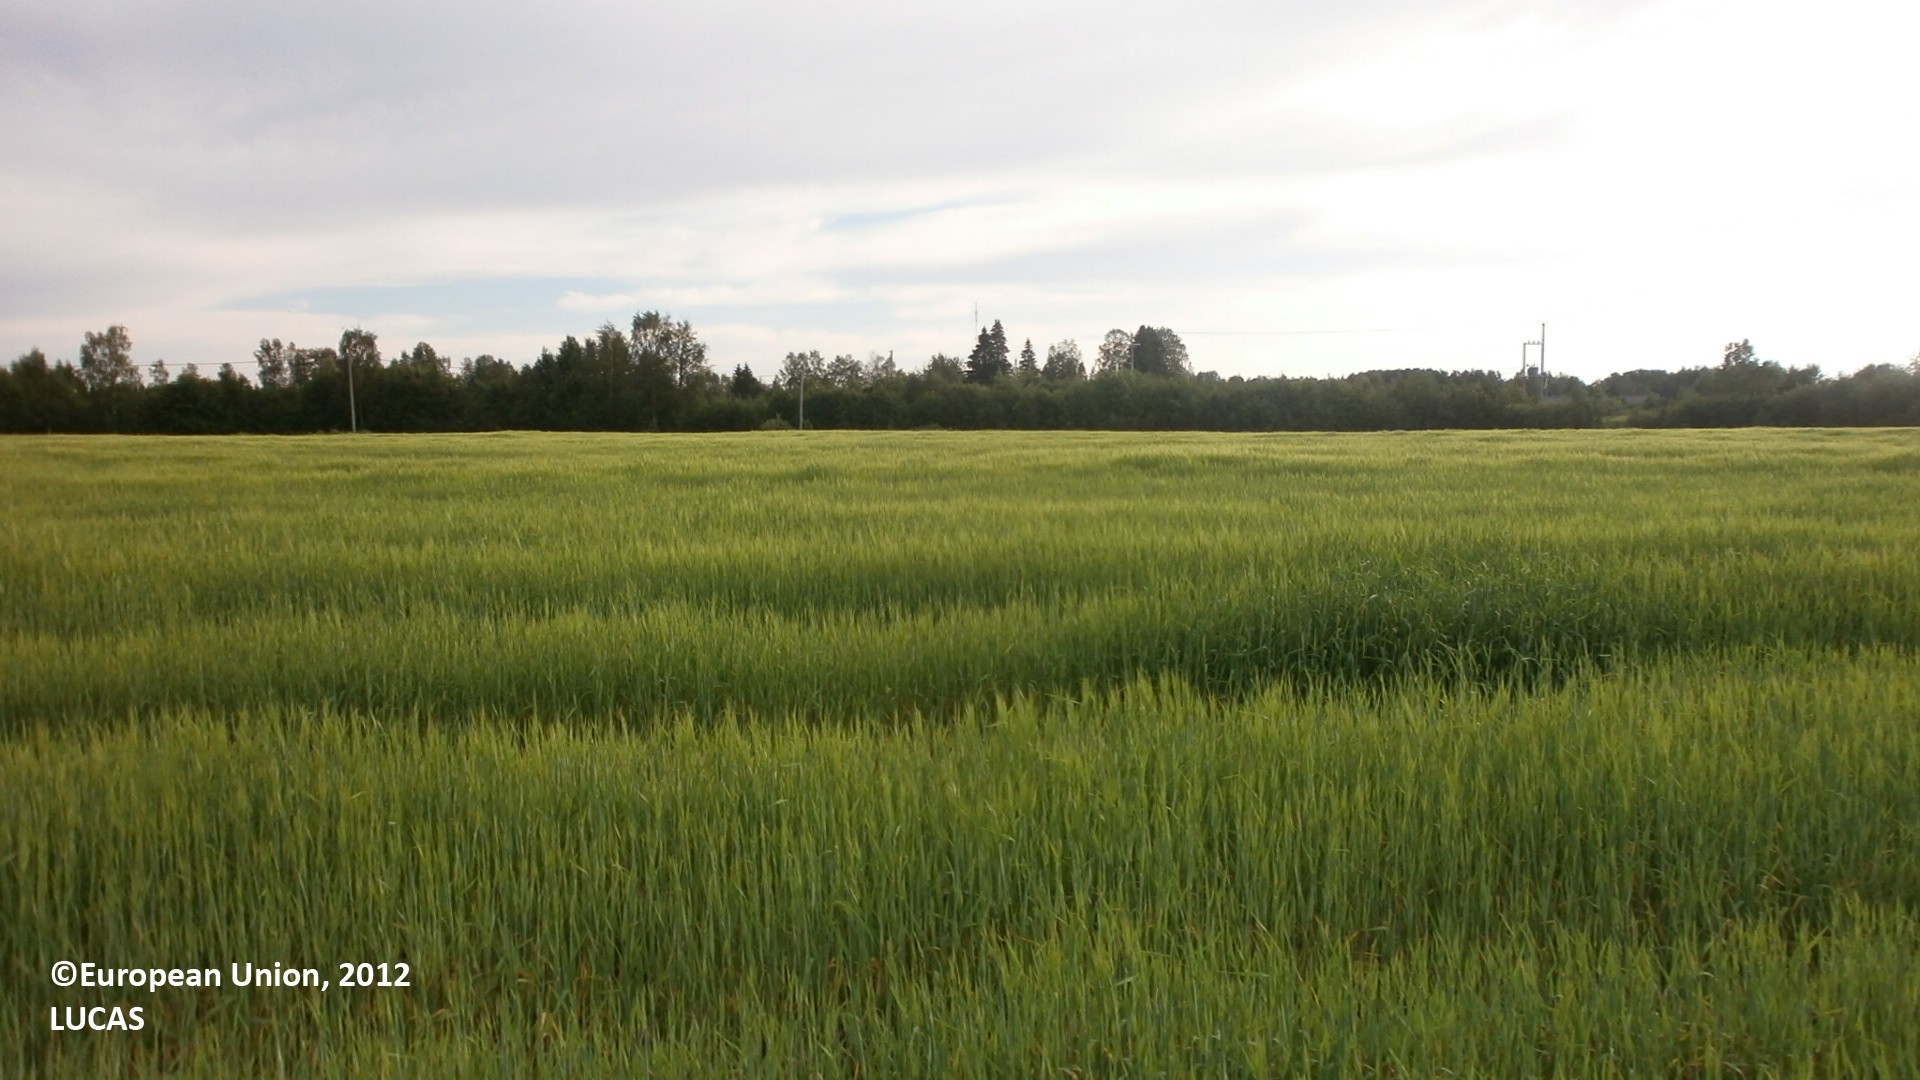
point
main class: Cropland
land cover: Barley
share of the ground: > 75 %
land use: Agriculture (excluding fallow land and kitchen gardens)
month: July
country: FI
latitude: 64.4073
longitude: 24.3209
